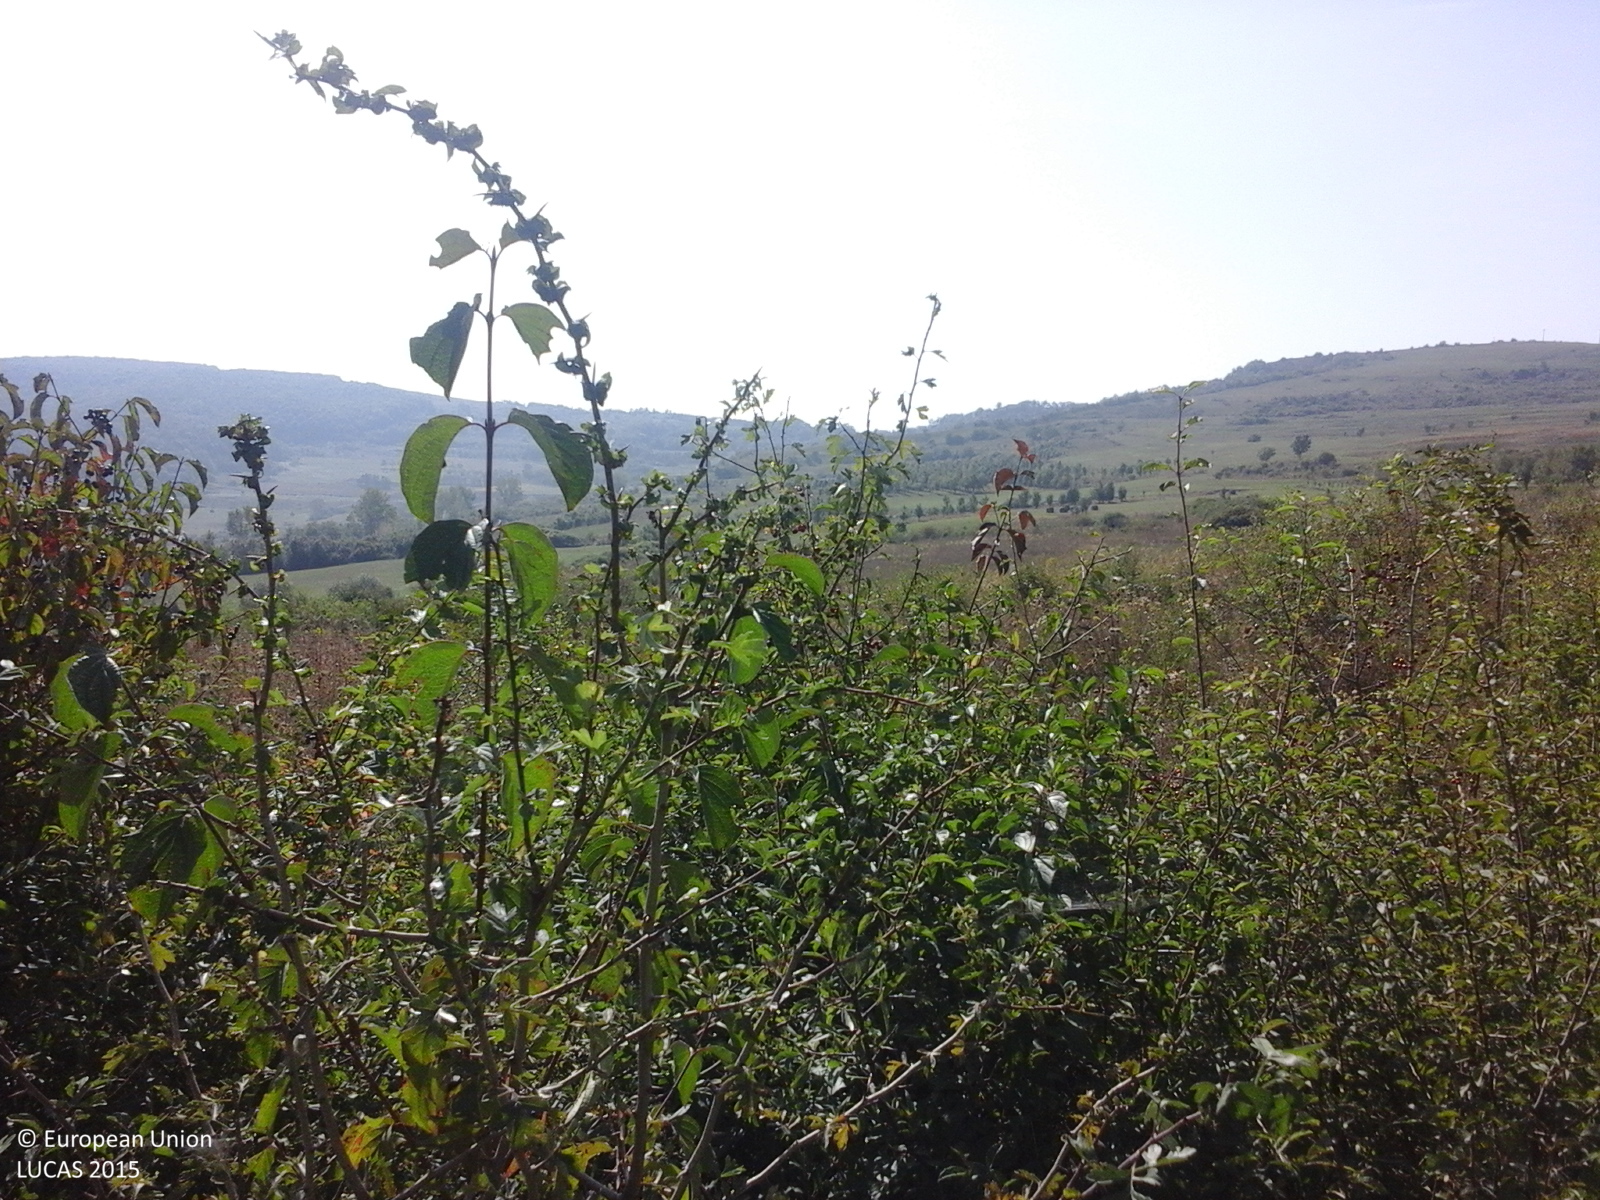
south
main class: Shrubland
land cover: Shrubland without tree cover
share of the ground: > 75 %
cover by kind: shrubs 100 %
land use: Semi-natural and natural areas not in use
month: September
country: RO
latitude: 47.0959
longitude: 23.7916
